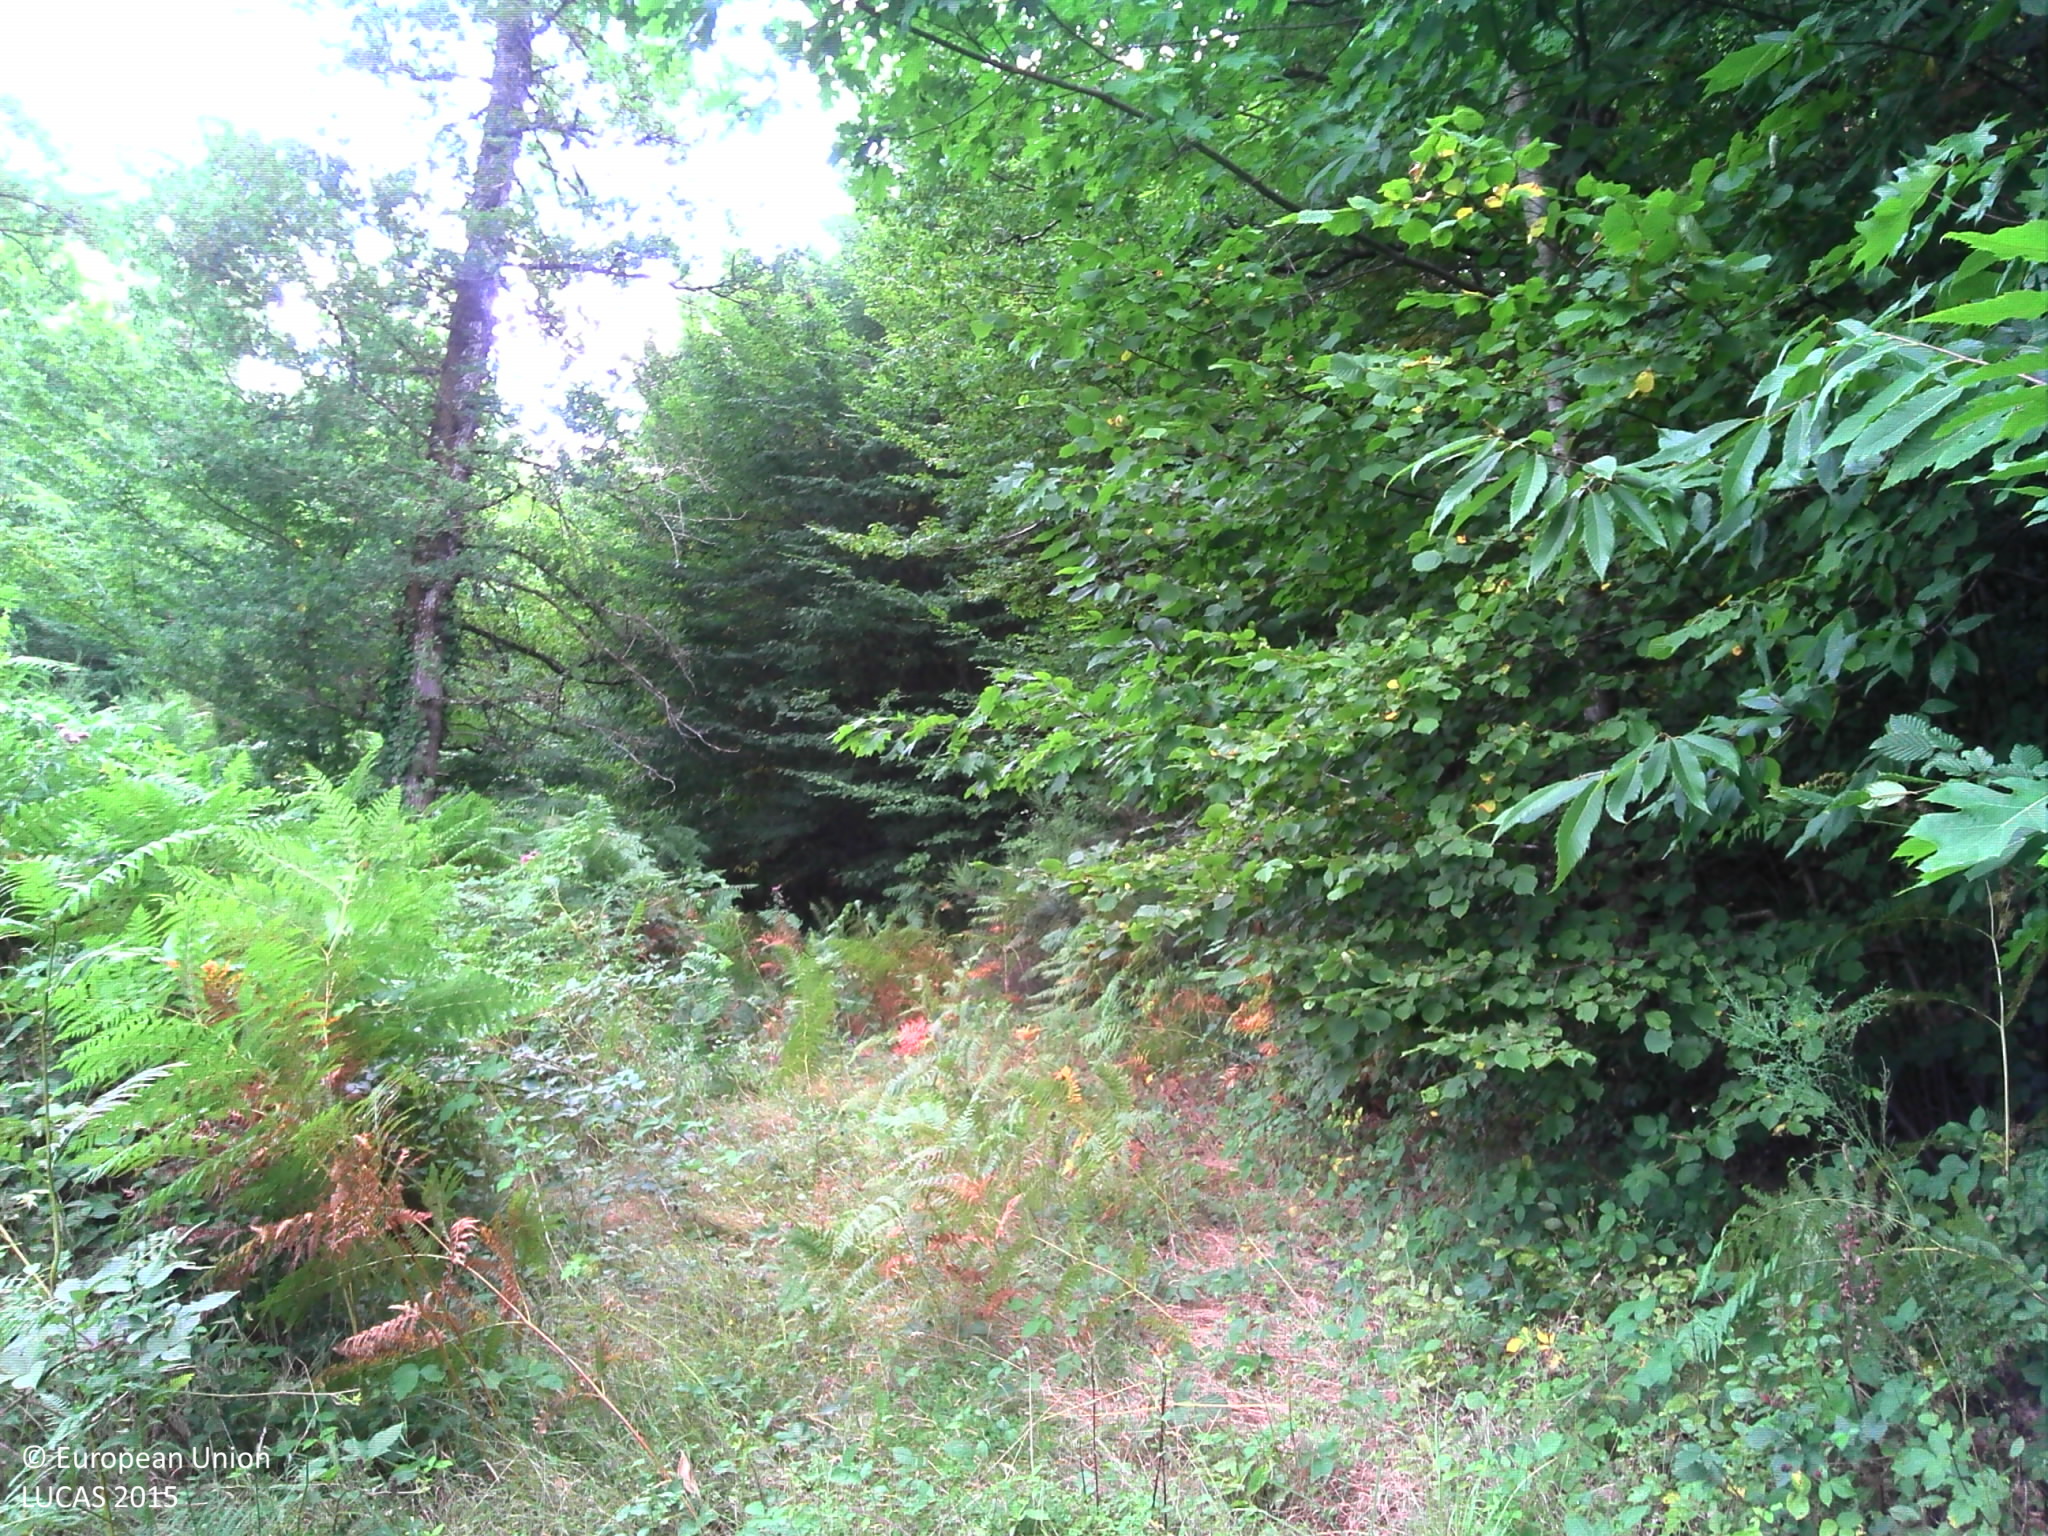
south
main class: Woodland
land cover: Broadleaved woodland
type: mesophytic deciduous forest
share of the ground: > 75 %
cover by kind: broadleaved forest trees 75 %, herbaceous plants 10 %, lichens and mosses 10 %, shrubs 5 %
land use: Forestry
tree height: > 5 m
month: August
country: FR
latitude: 45.5083
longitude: 0.4767
